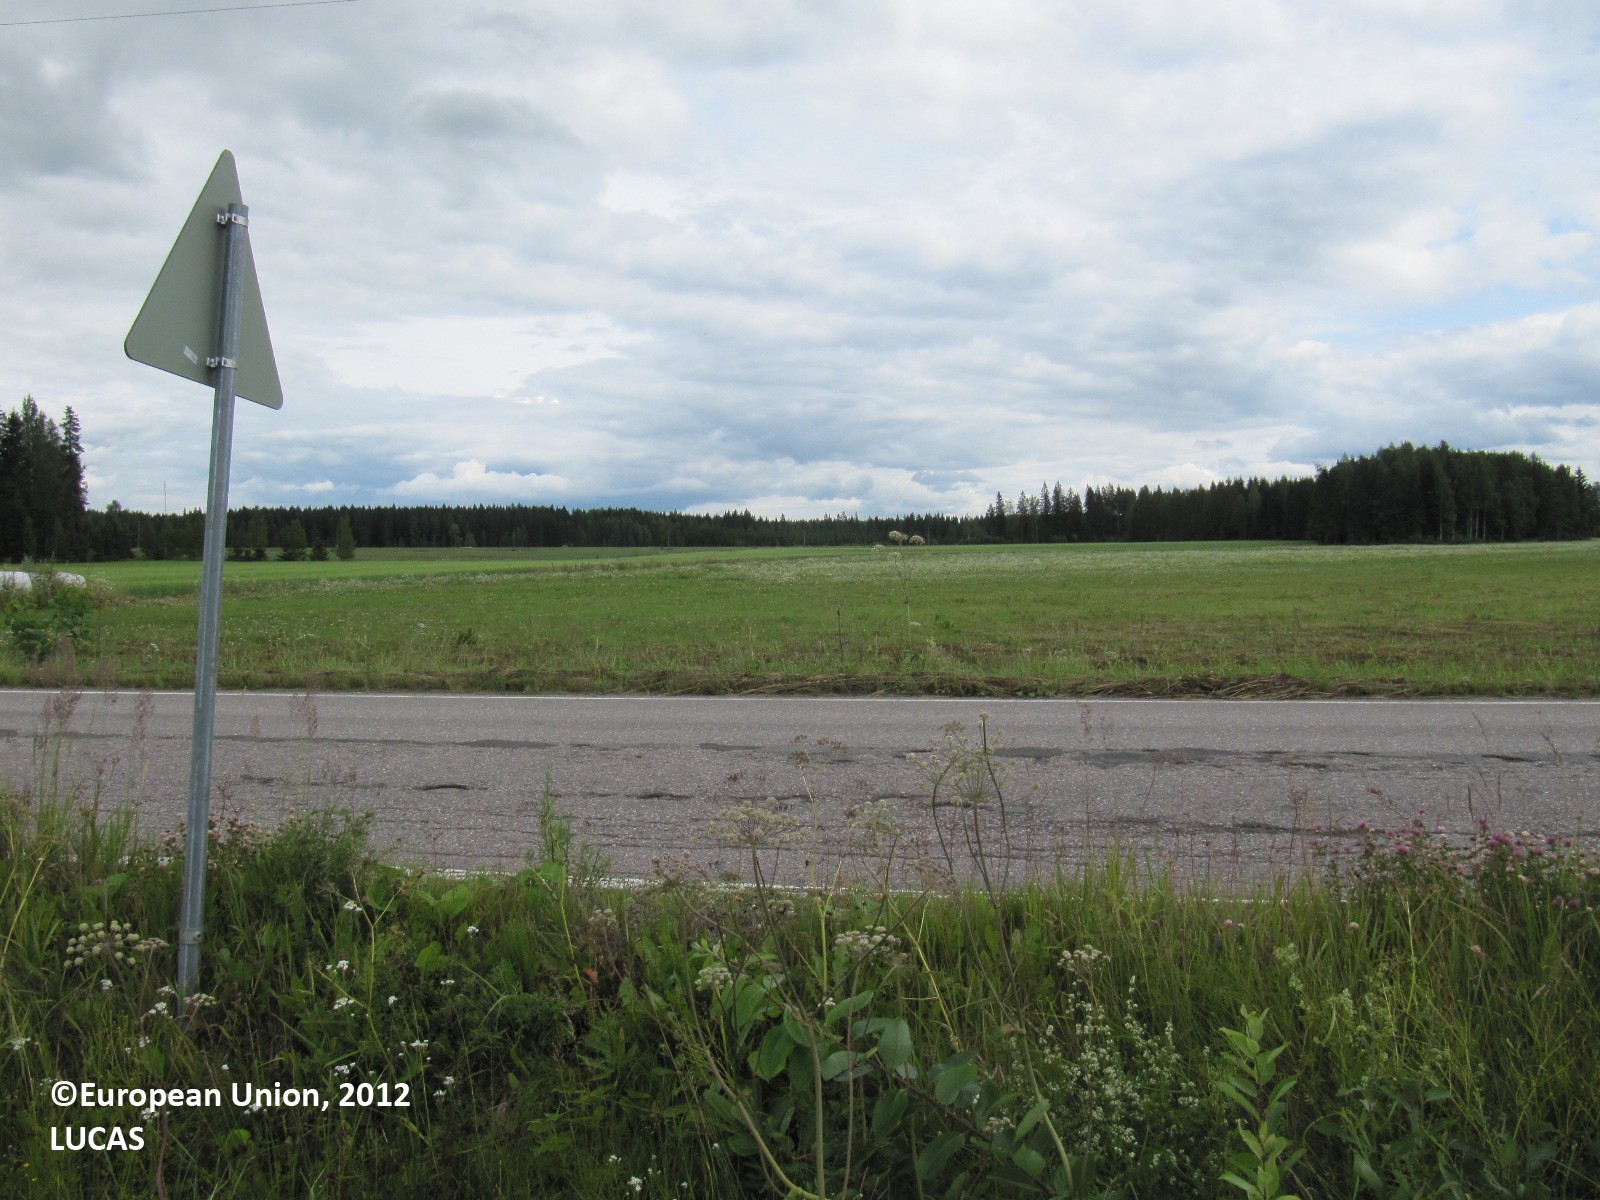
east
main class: Cropland
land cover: Oats
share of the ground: > 75 %
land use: Agriculture (excluding fallow land and kitchen gardens)
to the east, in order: Oats; Spontaneously vegetated surfaces; Paved roads, cycling and walking lanes; Spontaneously vegetated surfaces; Electric lines; Spontaneously vegetated surfaces
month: July
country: FI
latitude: 60.7847
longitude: 24.6727
